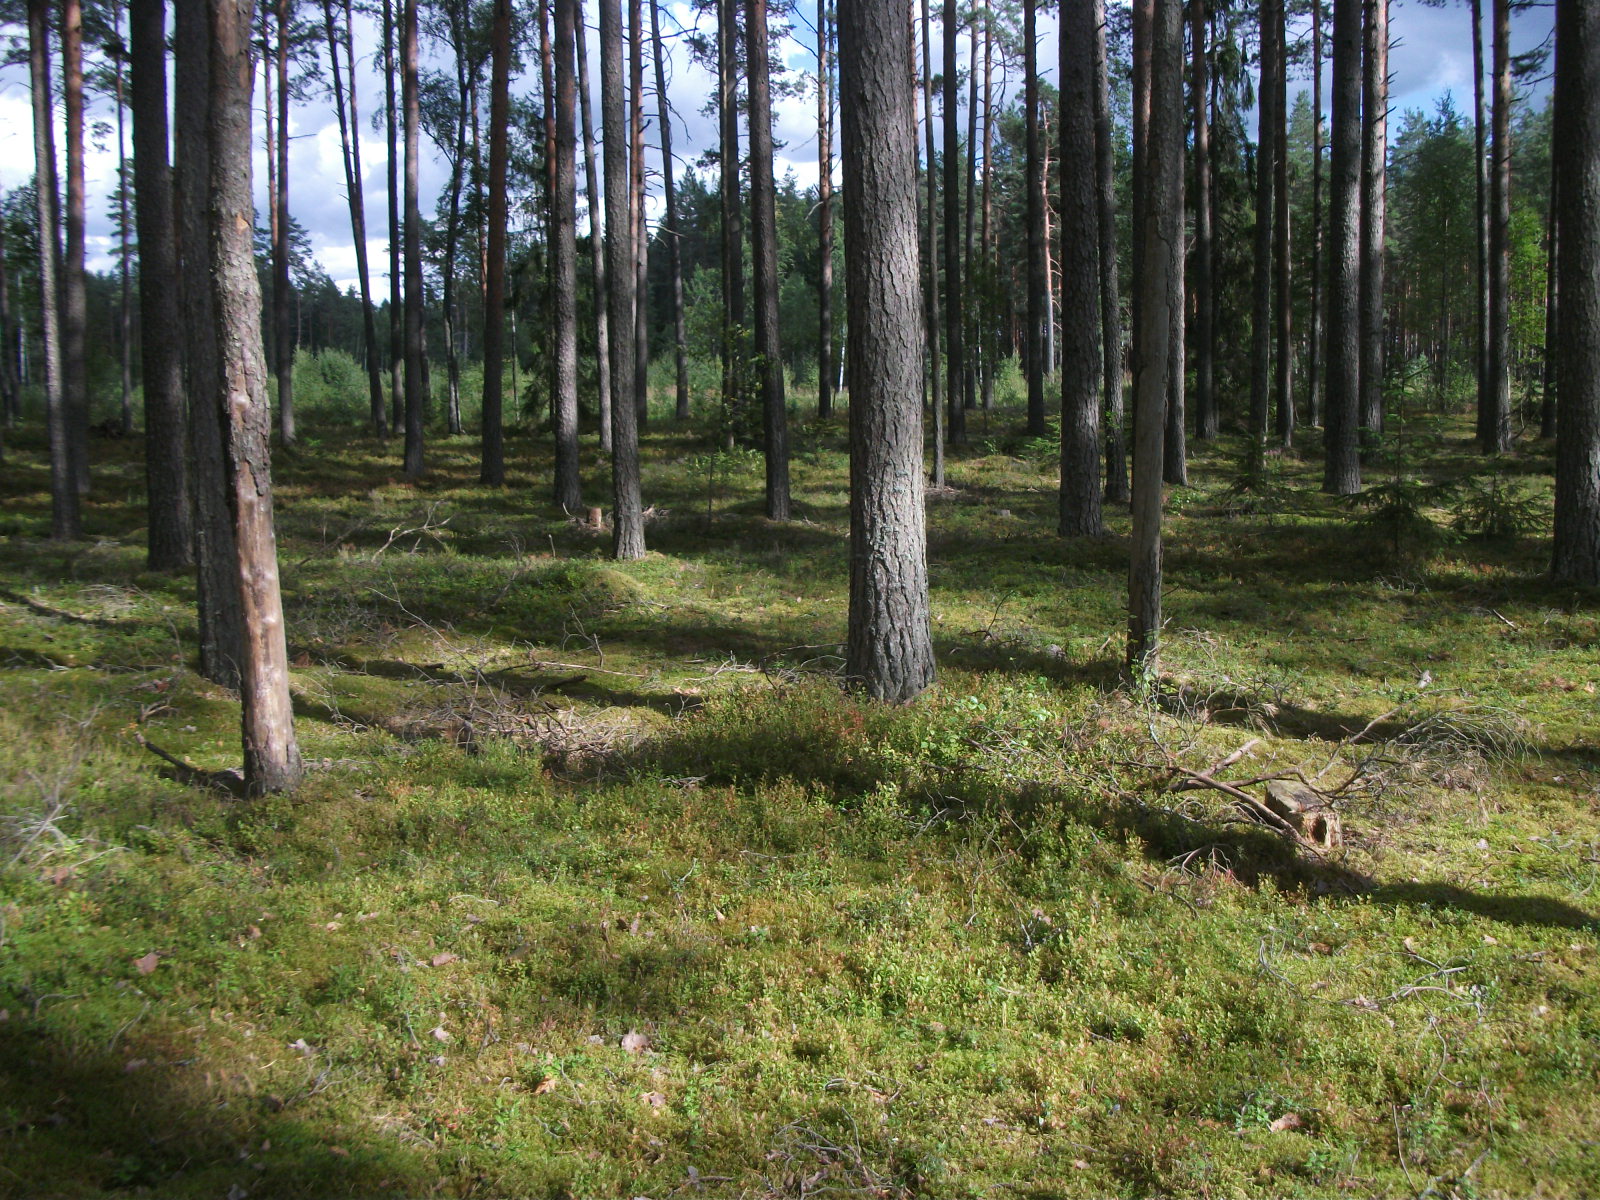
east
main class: Woodland
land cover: Pine dominated coniferous woodland
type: hemiboreal forest and nemoral coniferous forest and mixed broadleaved-coniferous forest
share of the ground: > 75 %
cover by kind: coniferous forest trees 80 %, lichens and mosses 20 %
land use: Forestry
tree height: > 5 m
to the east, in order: Pine dominated coniferous woodland; Shrubland with sparse tree cover; Paved roads, cycling and walking lanes; Pine dominated mixed woodland; Broadleaved woodland
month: August
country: LV
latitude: 56.4658
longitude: 26.3918
